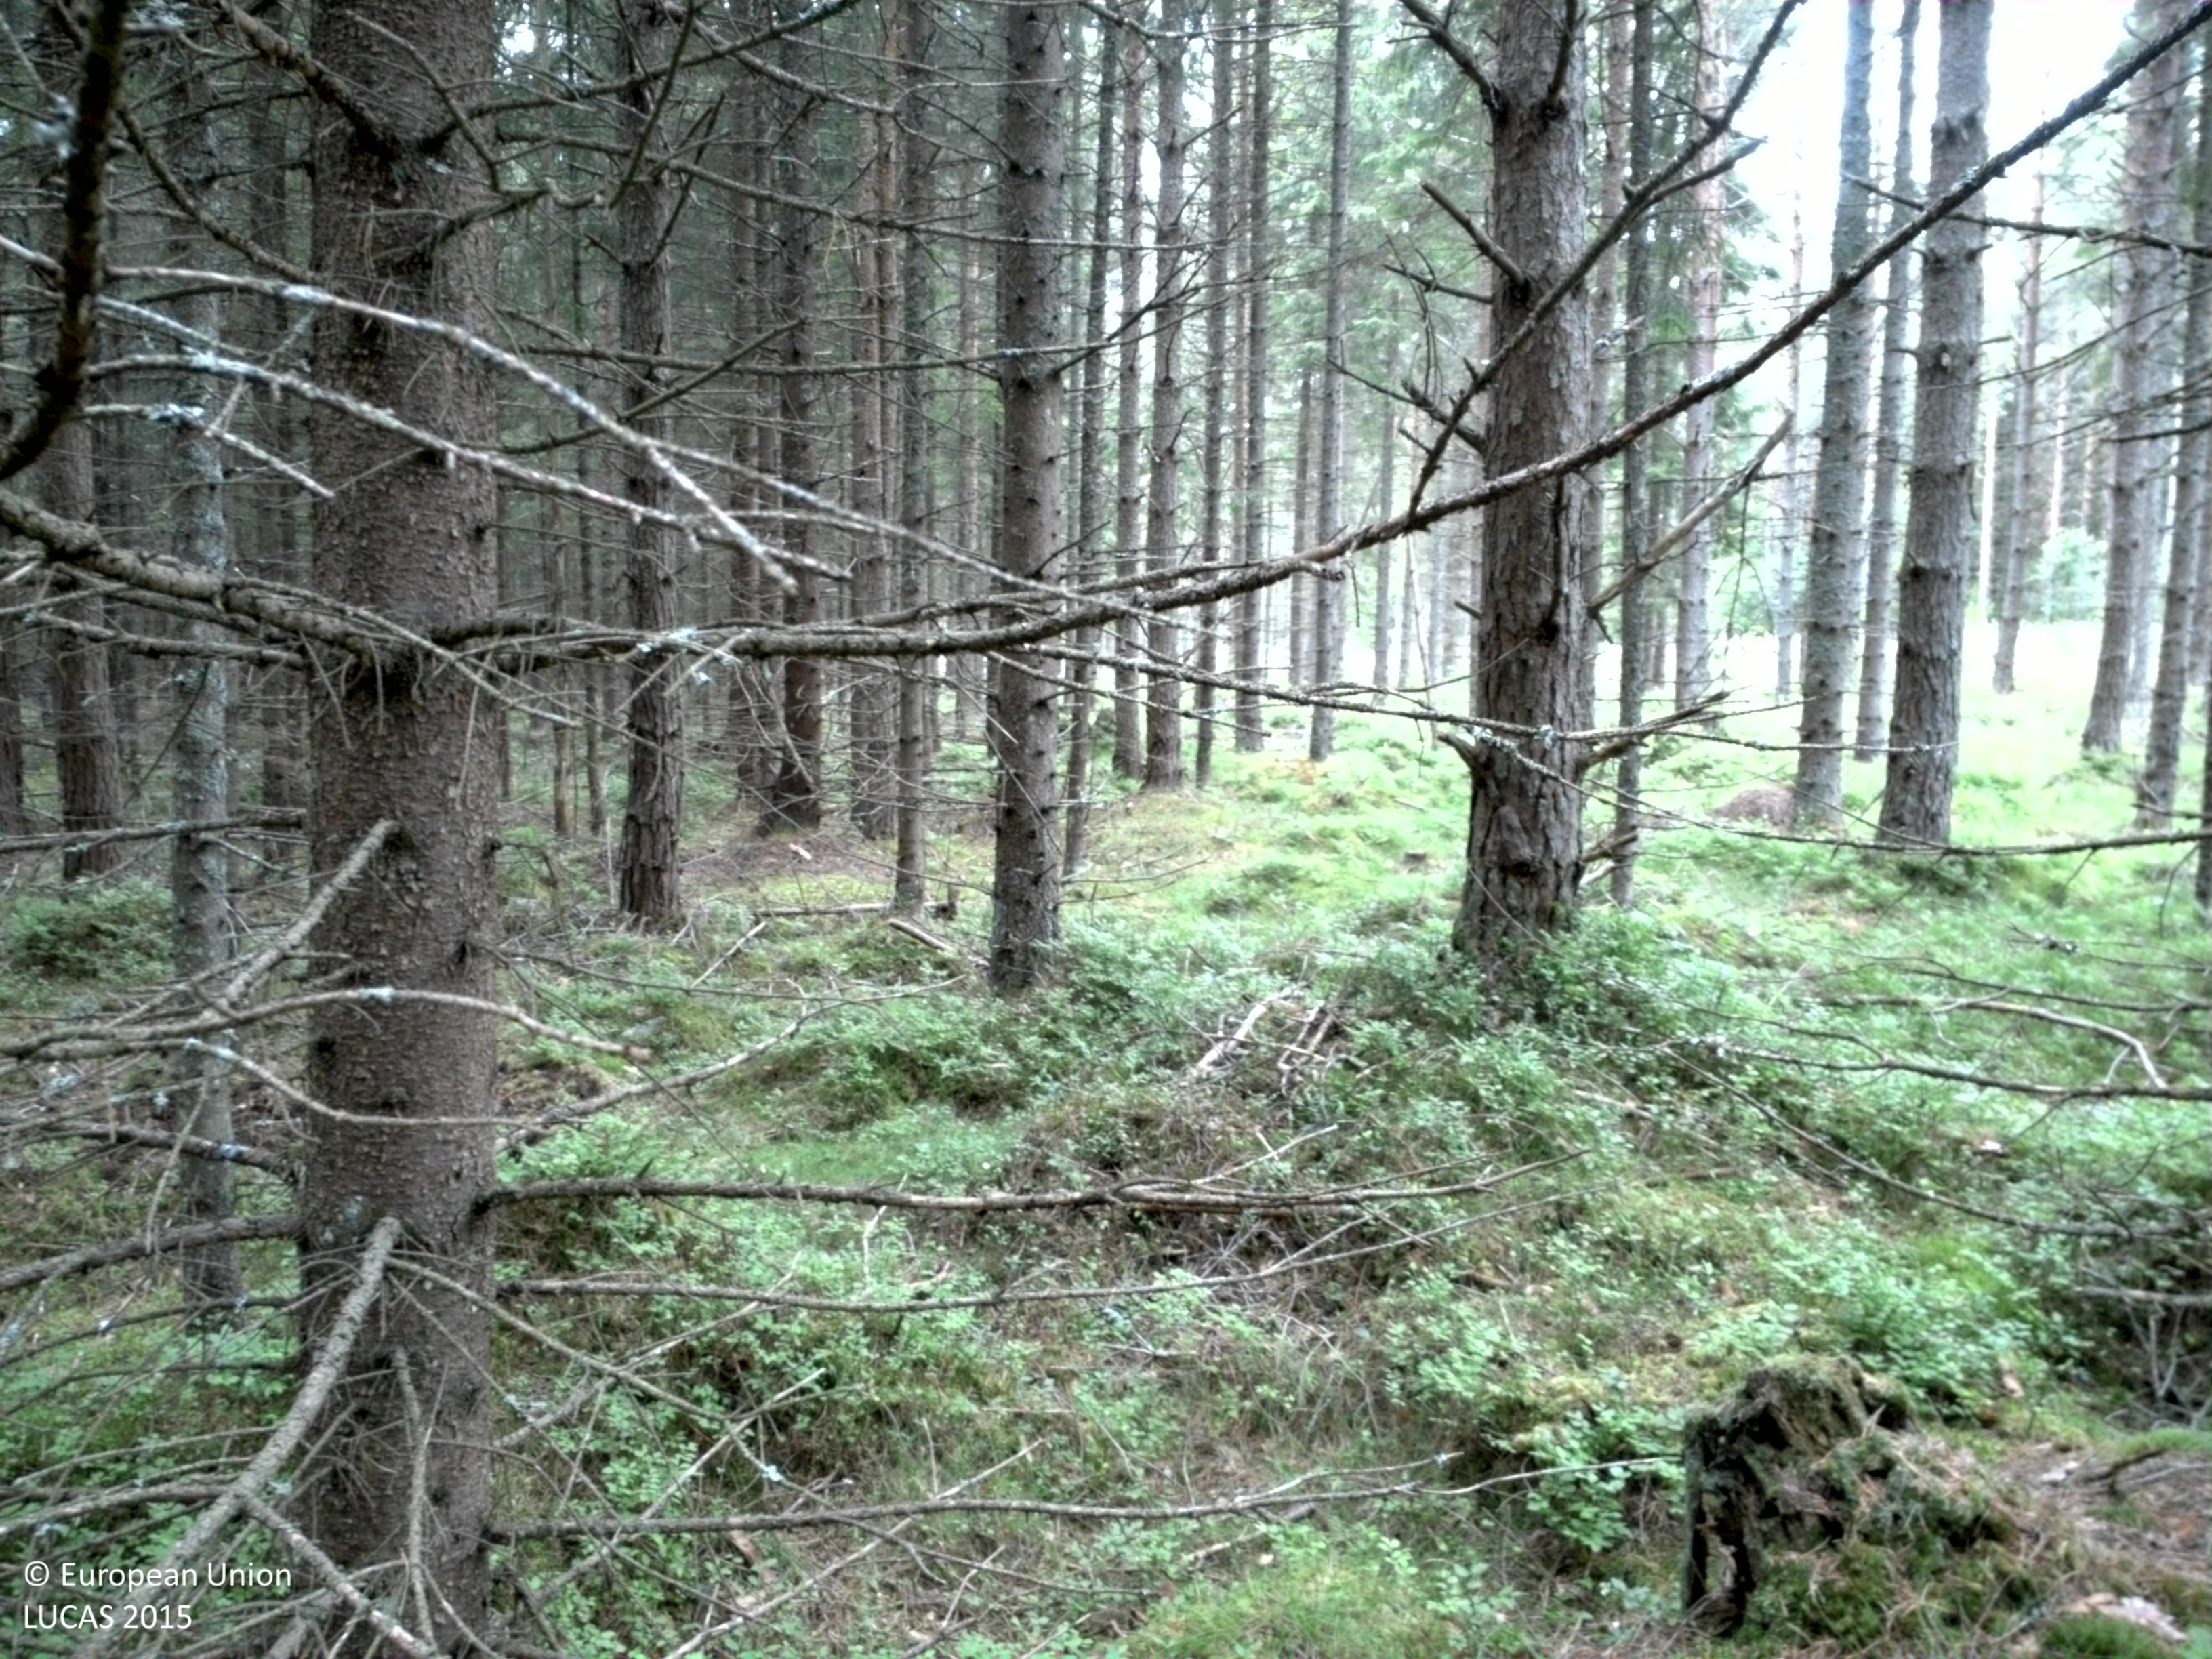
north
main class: Woodland
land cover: Other coniferous woodland
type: boreal forest
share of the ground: 25 - 50 %
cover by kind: coniferous forest trees 45 %, herbaceous plants 35 %, lichens and mosses 20 %
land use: Forestry
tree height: > 5 m
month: July
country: SE
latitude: 58.9385
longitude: 14.4582
